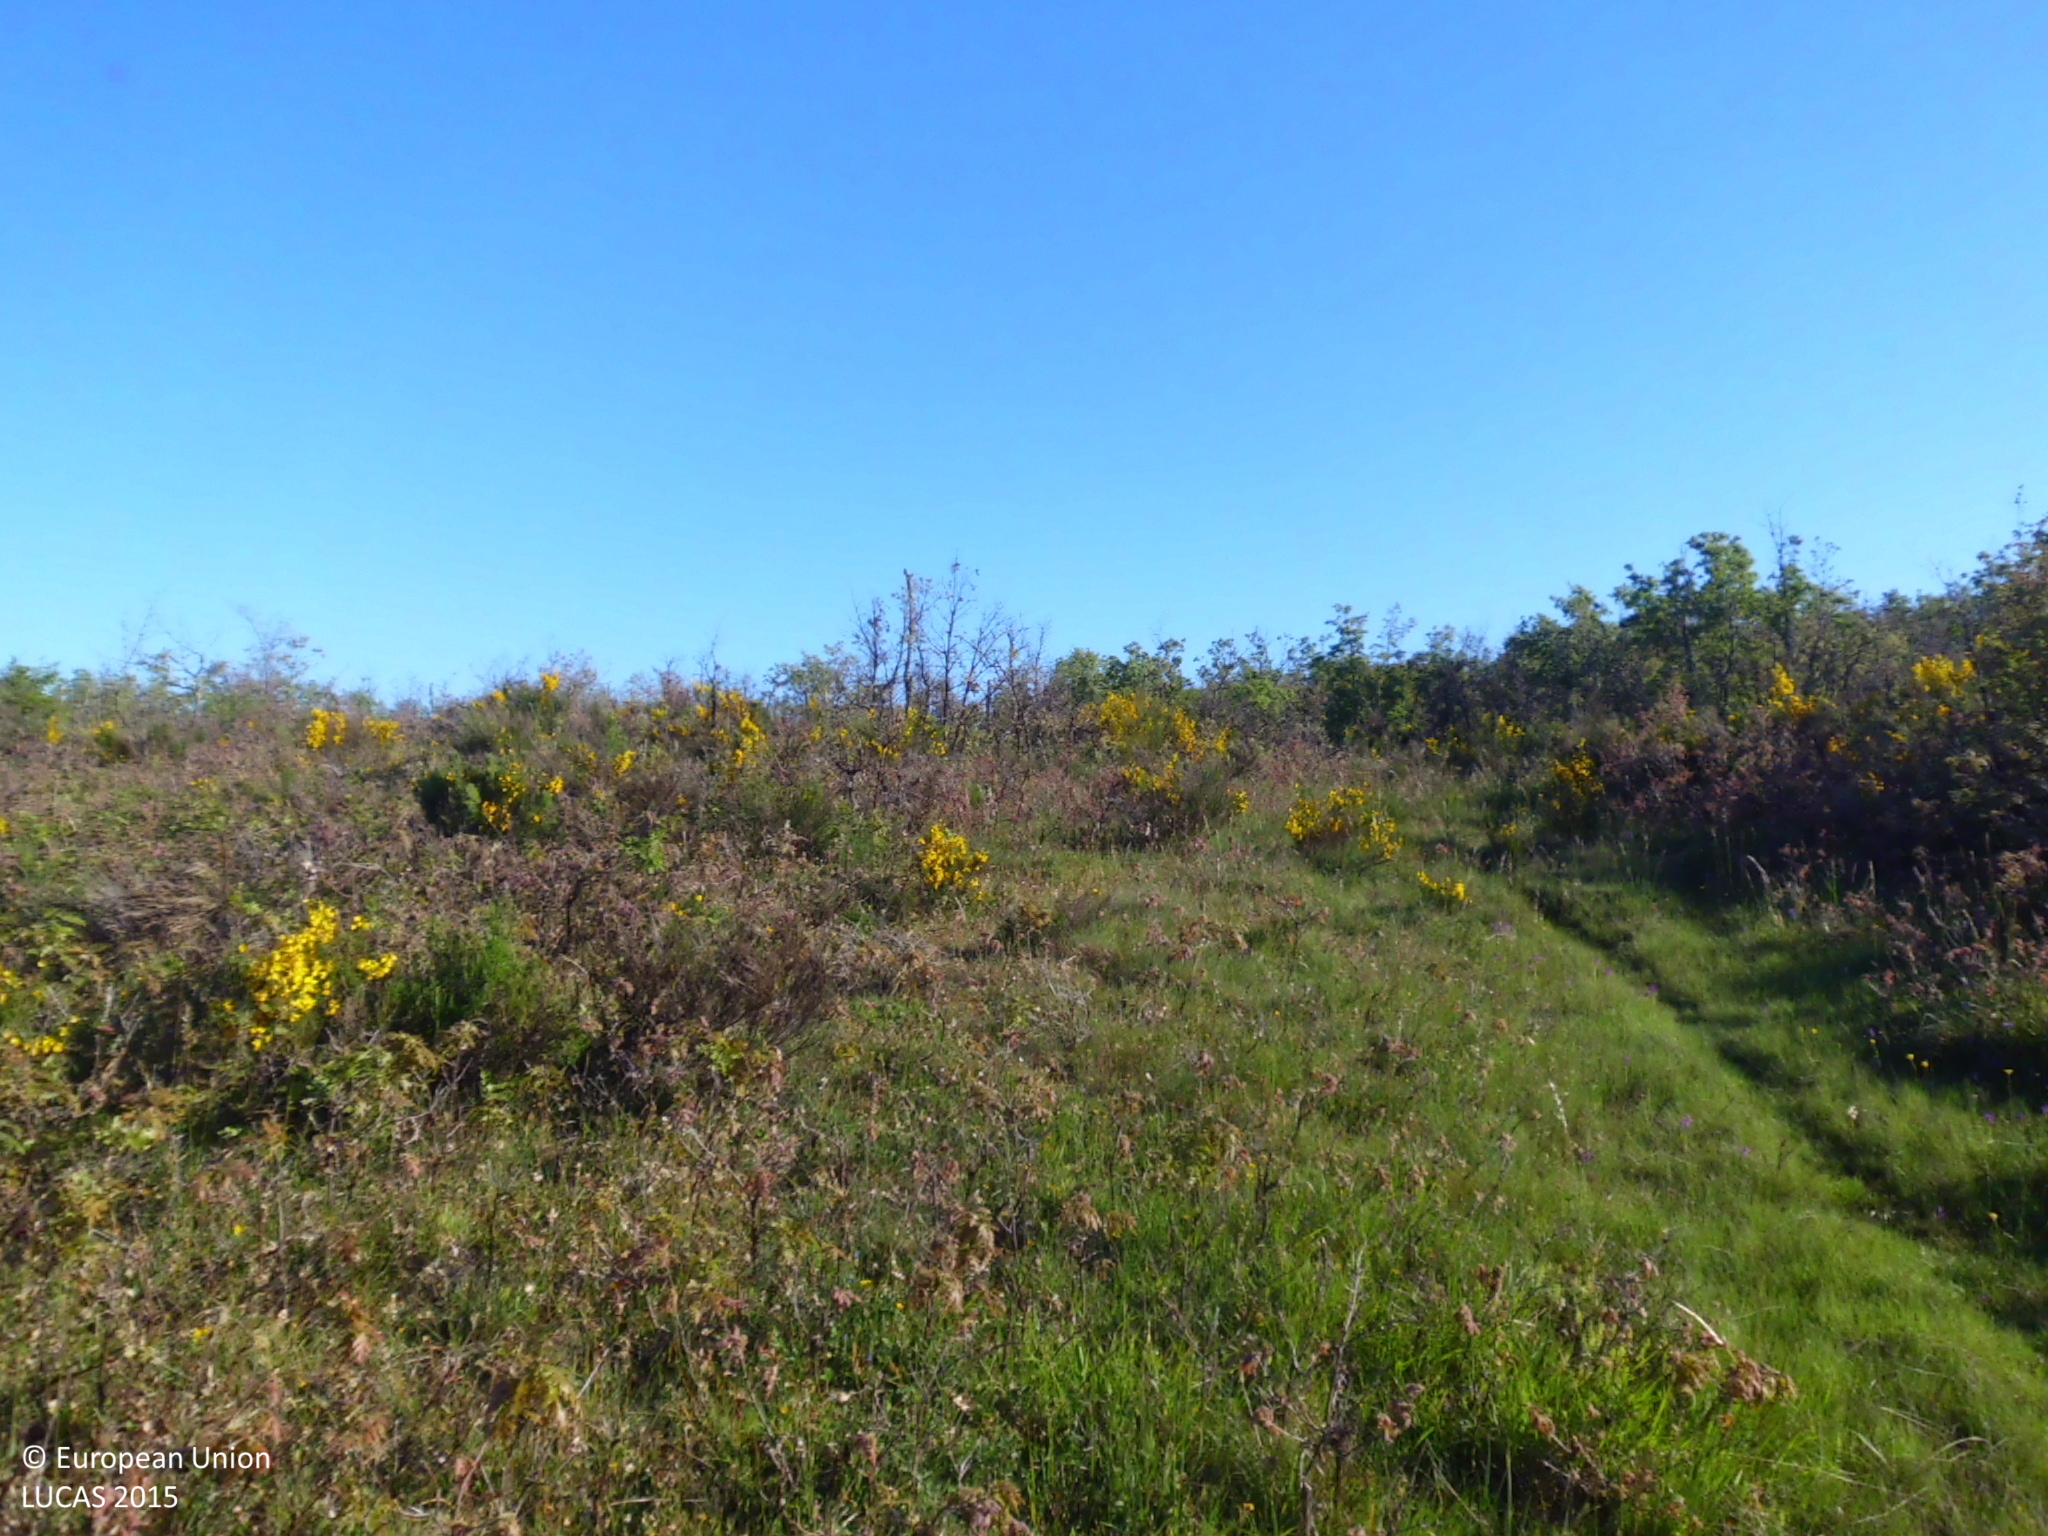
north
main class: Woodland
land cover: Broadleaved woodland
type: acidophilous oak and oak-birch forest
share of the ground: > 75 %
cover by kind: broadleaved forest trees 75 %, herbaceous plants 15 %, shrubs 10 %
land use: Semi-natural and natural areas not in use
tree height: < 5 m
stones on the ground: 25 - 50 %
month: May
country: ES
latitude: 42.8700
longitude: -4.4869
